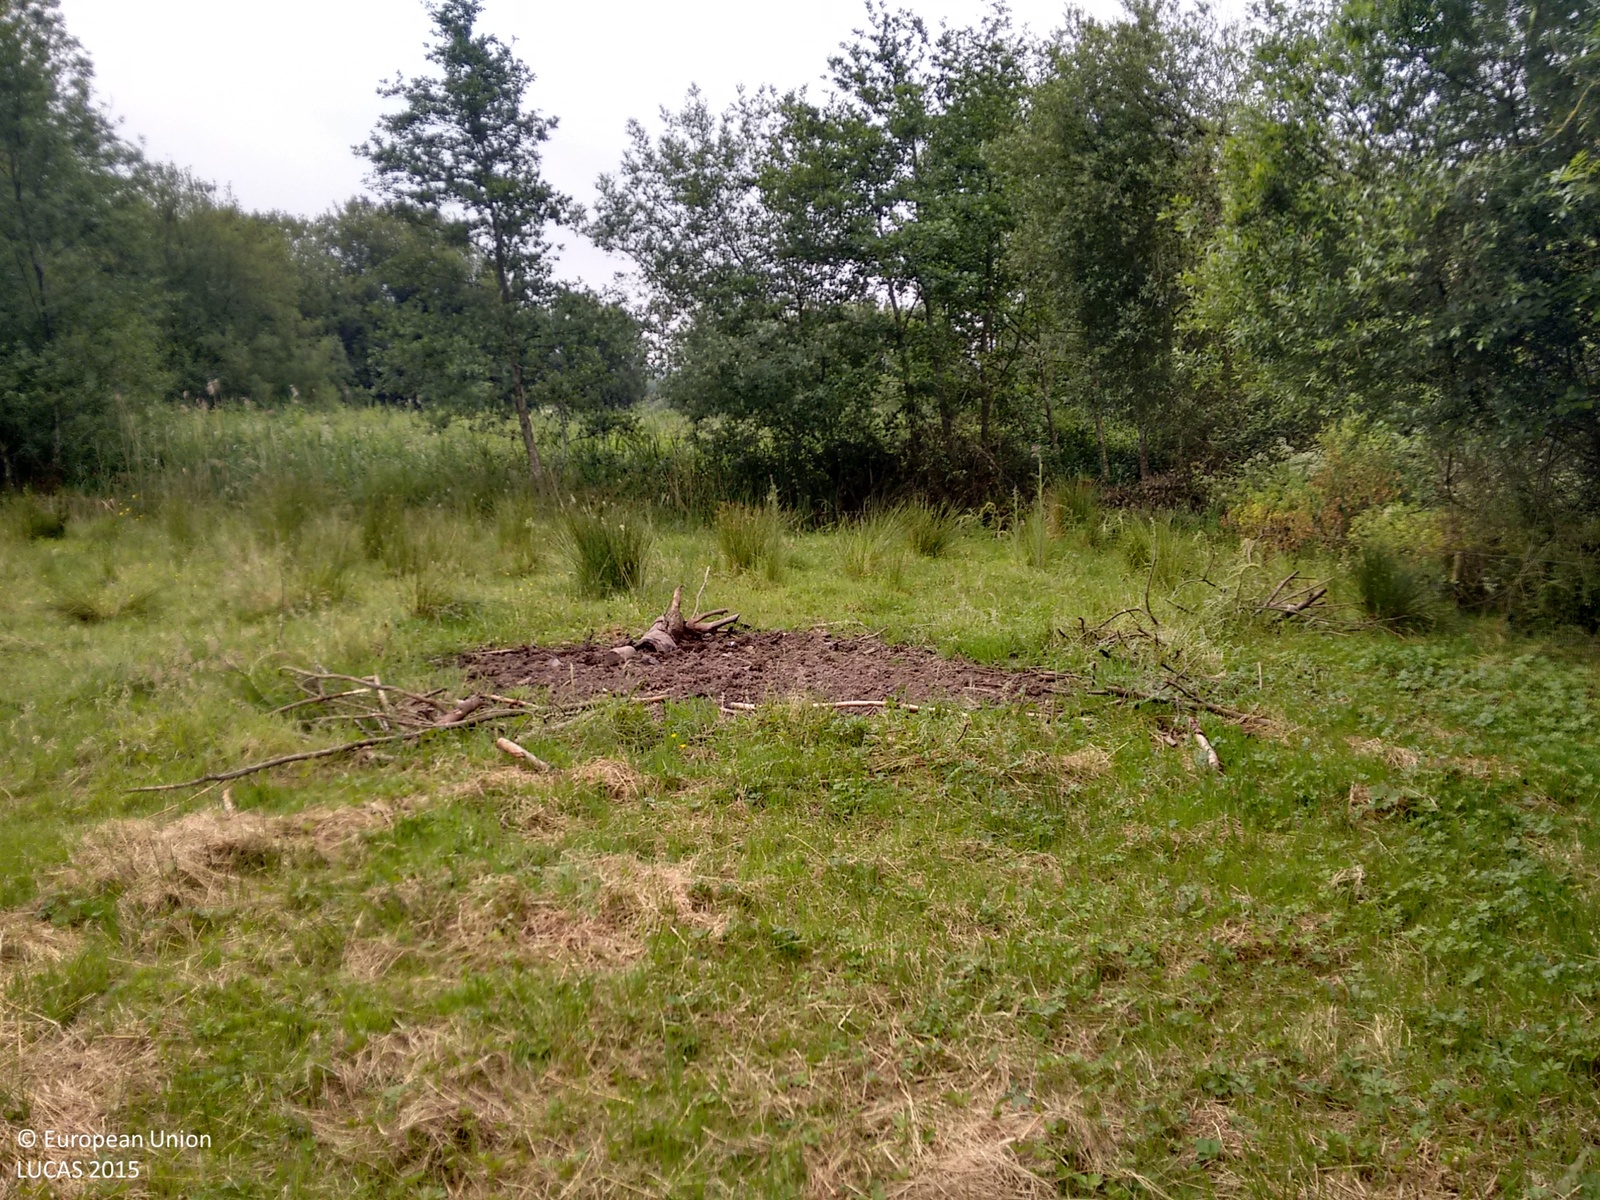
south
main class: Grassland
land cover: Grassland without tree/shrub cover
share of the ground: > 75 %
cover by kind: herbaceous plants 100 %
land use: Agriculture (excluding fallow land and kitchen gardens)
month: June
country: IE
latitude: 52.2474
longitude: -7.2133
